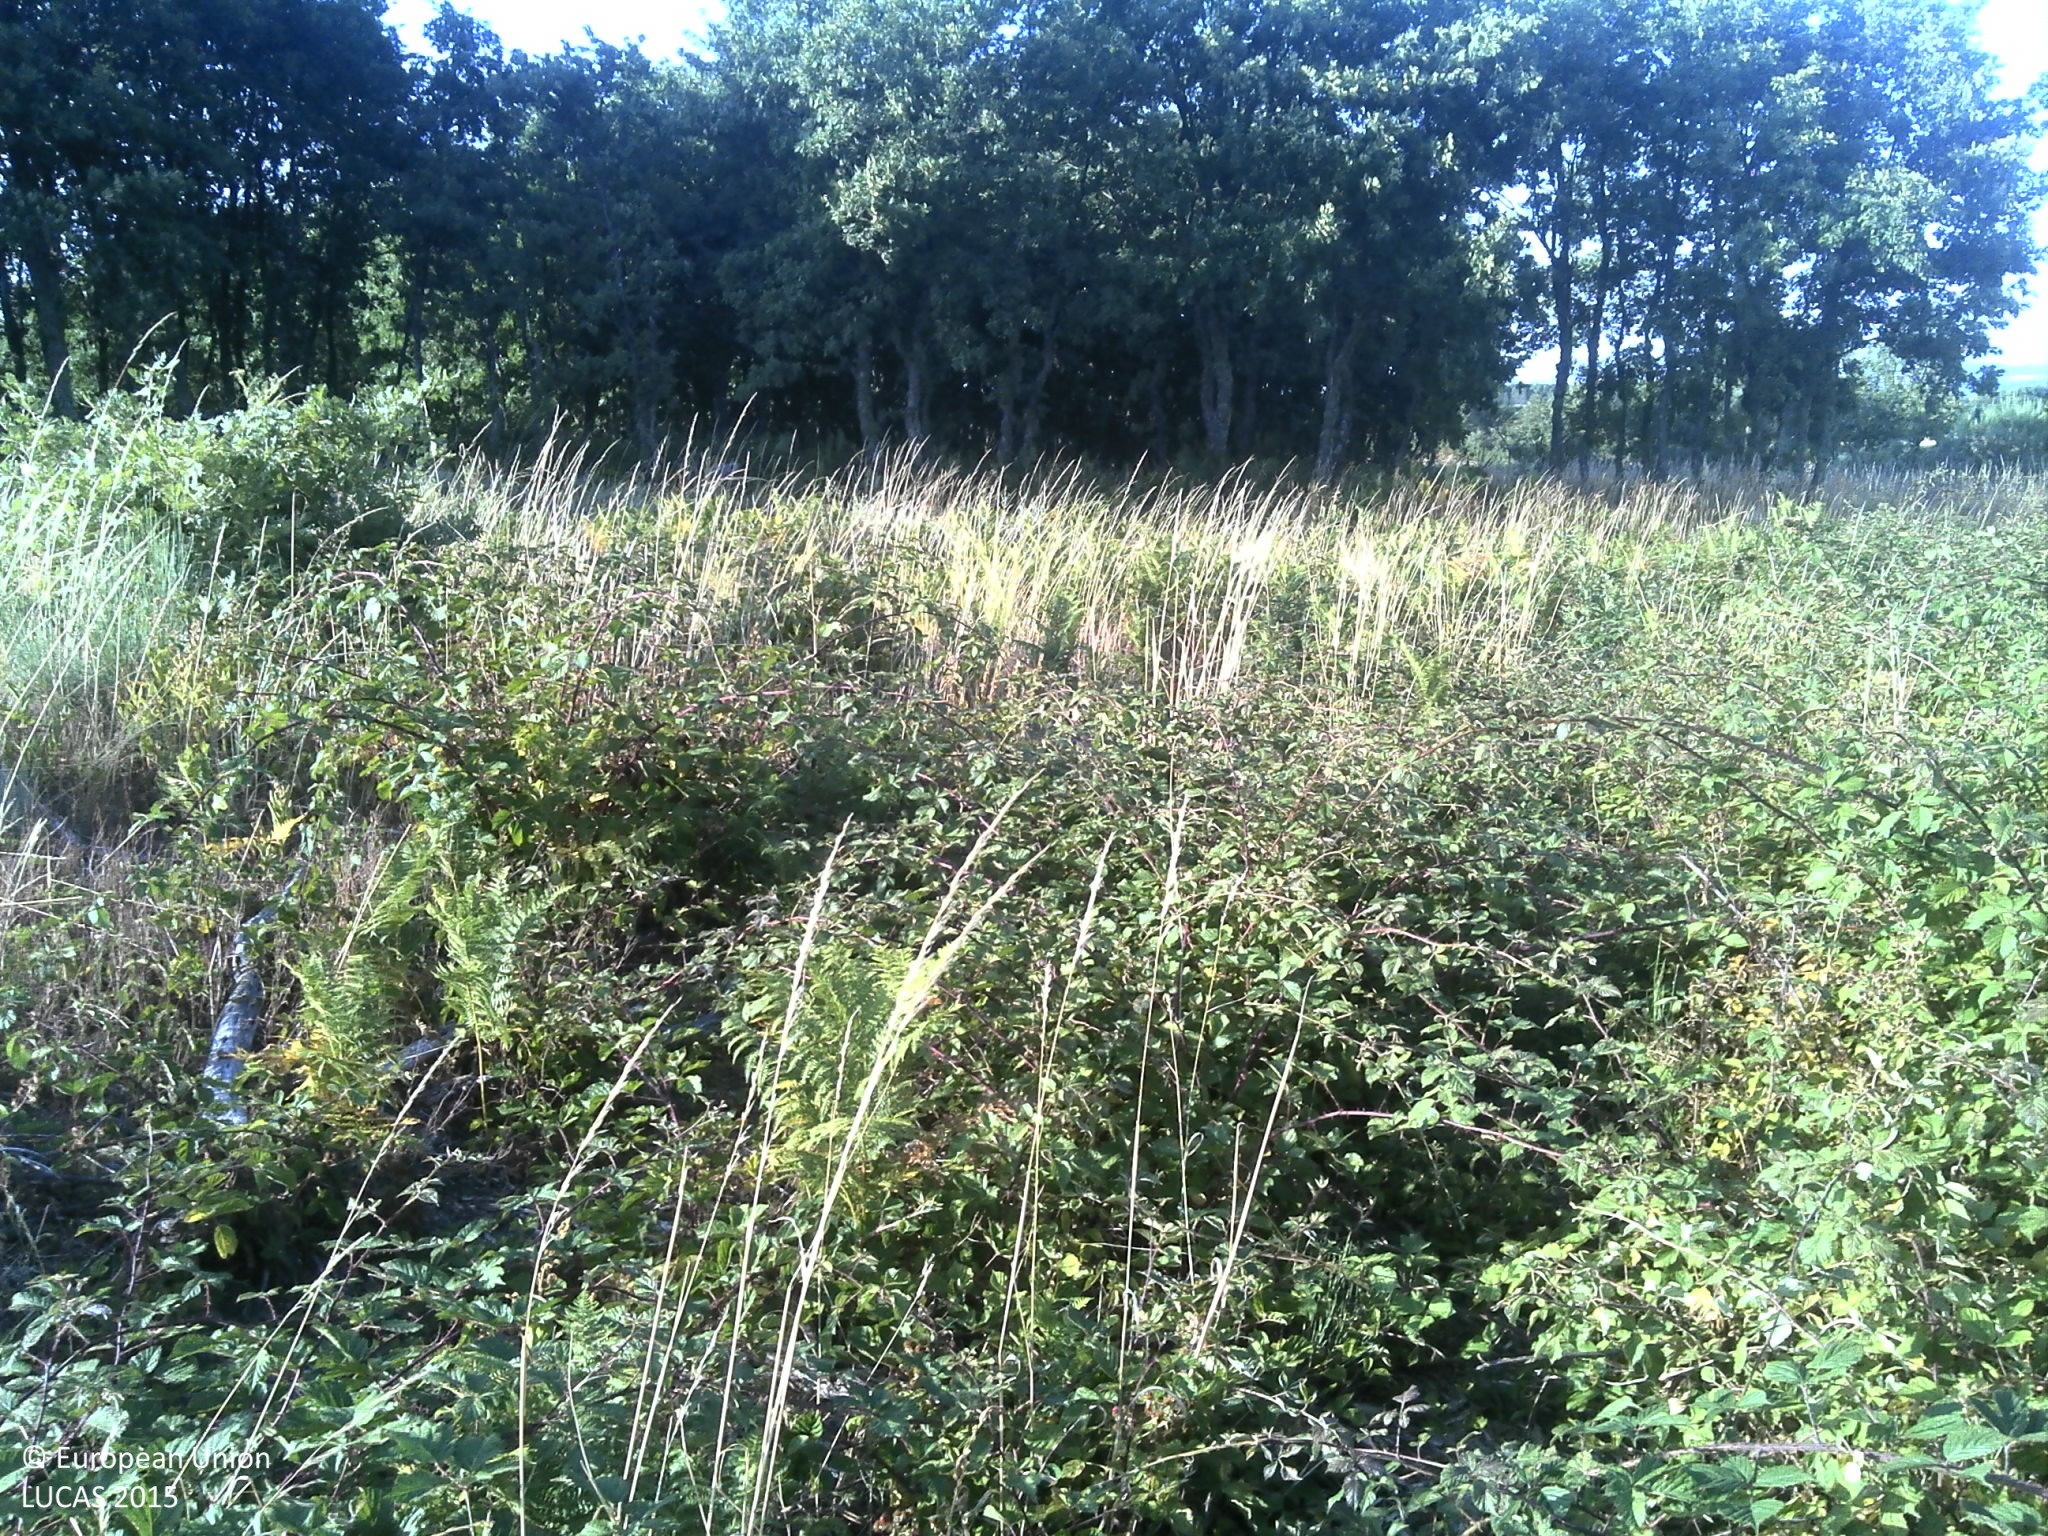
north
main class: Shrubland
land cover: Shrubland with sparse tree cover
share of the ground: 50 - 75 %
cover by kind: shrubs 55 %, unconsolidated bare surface 30 %, herbaceous plants 10 %, broadleaved forest trees 5 %
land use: Abandoned areas
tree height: > 5 m
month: July
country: PT
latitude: 40.8620
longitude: -7.3757
